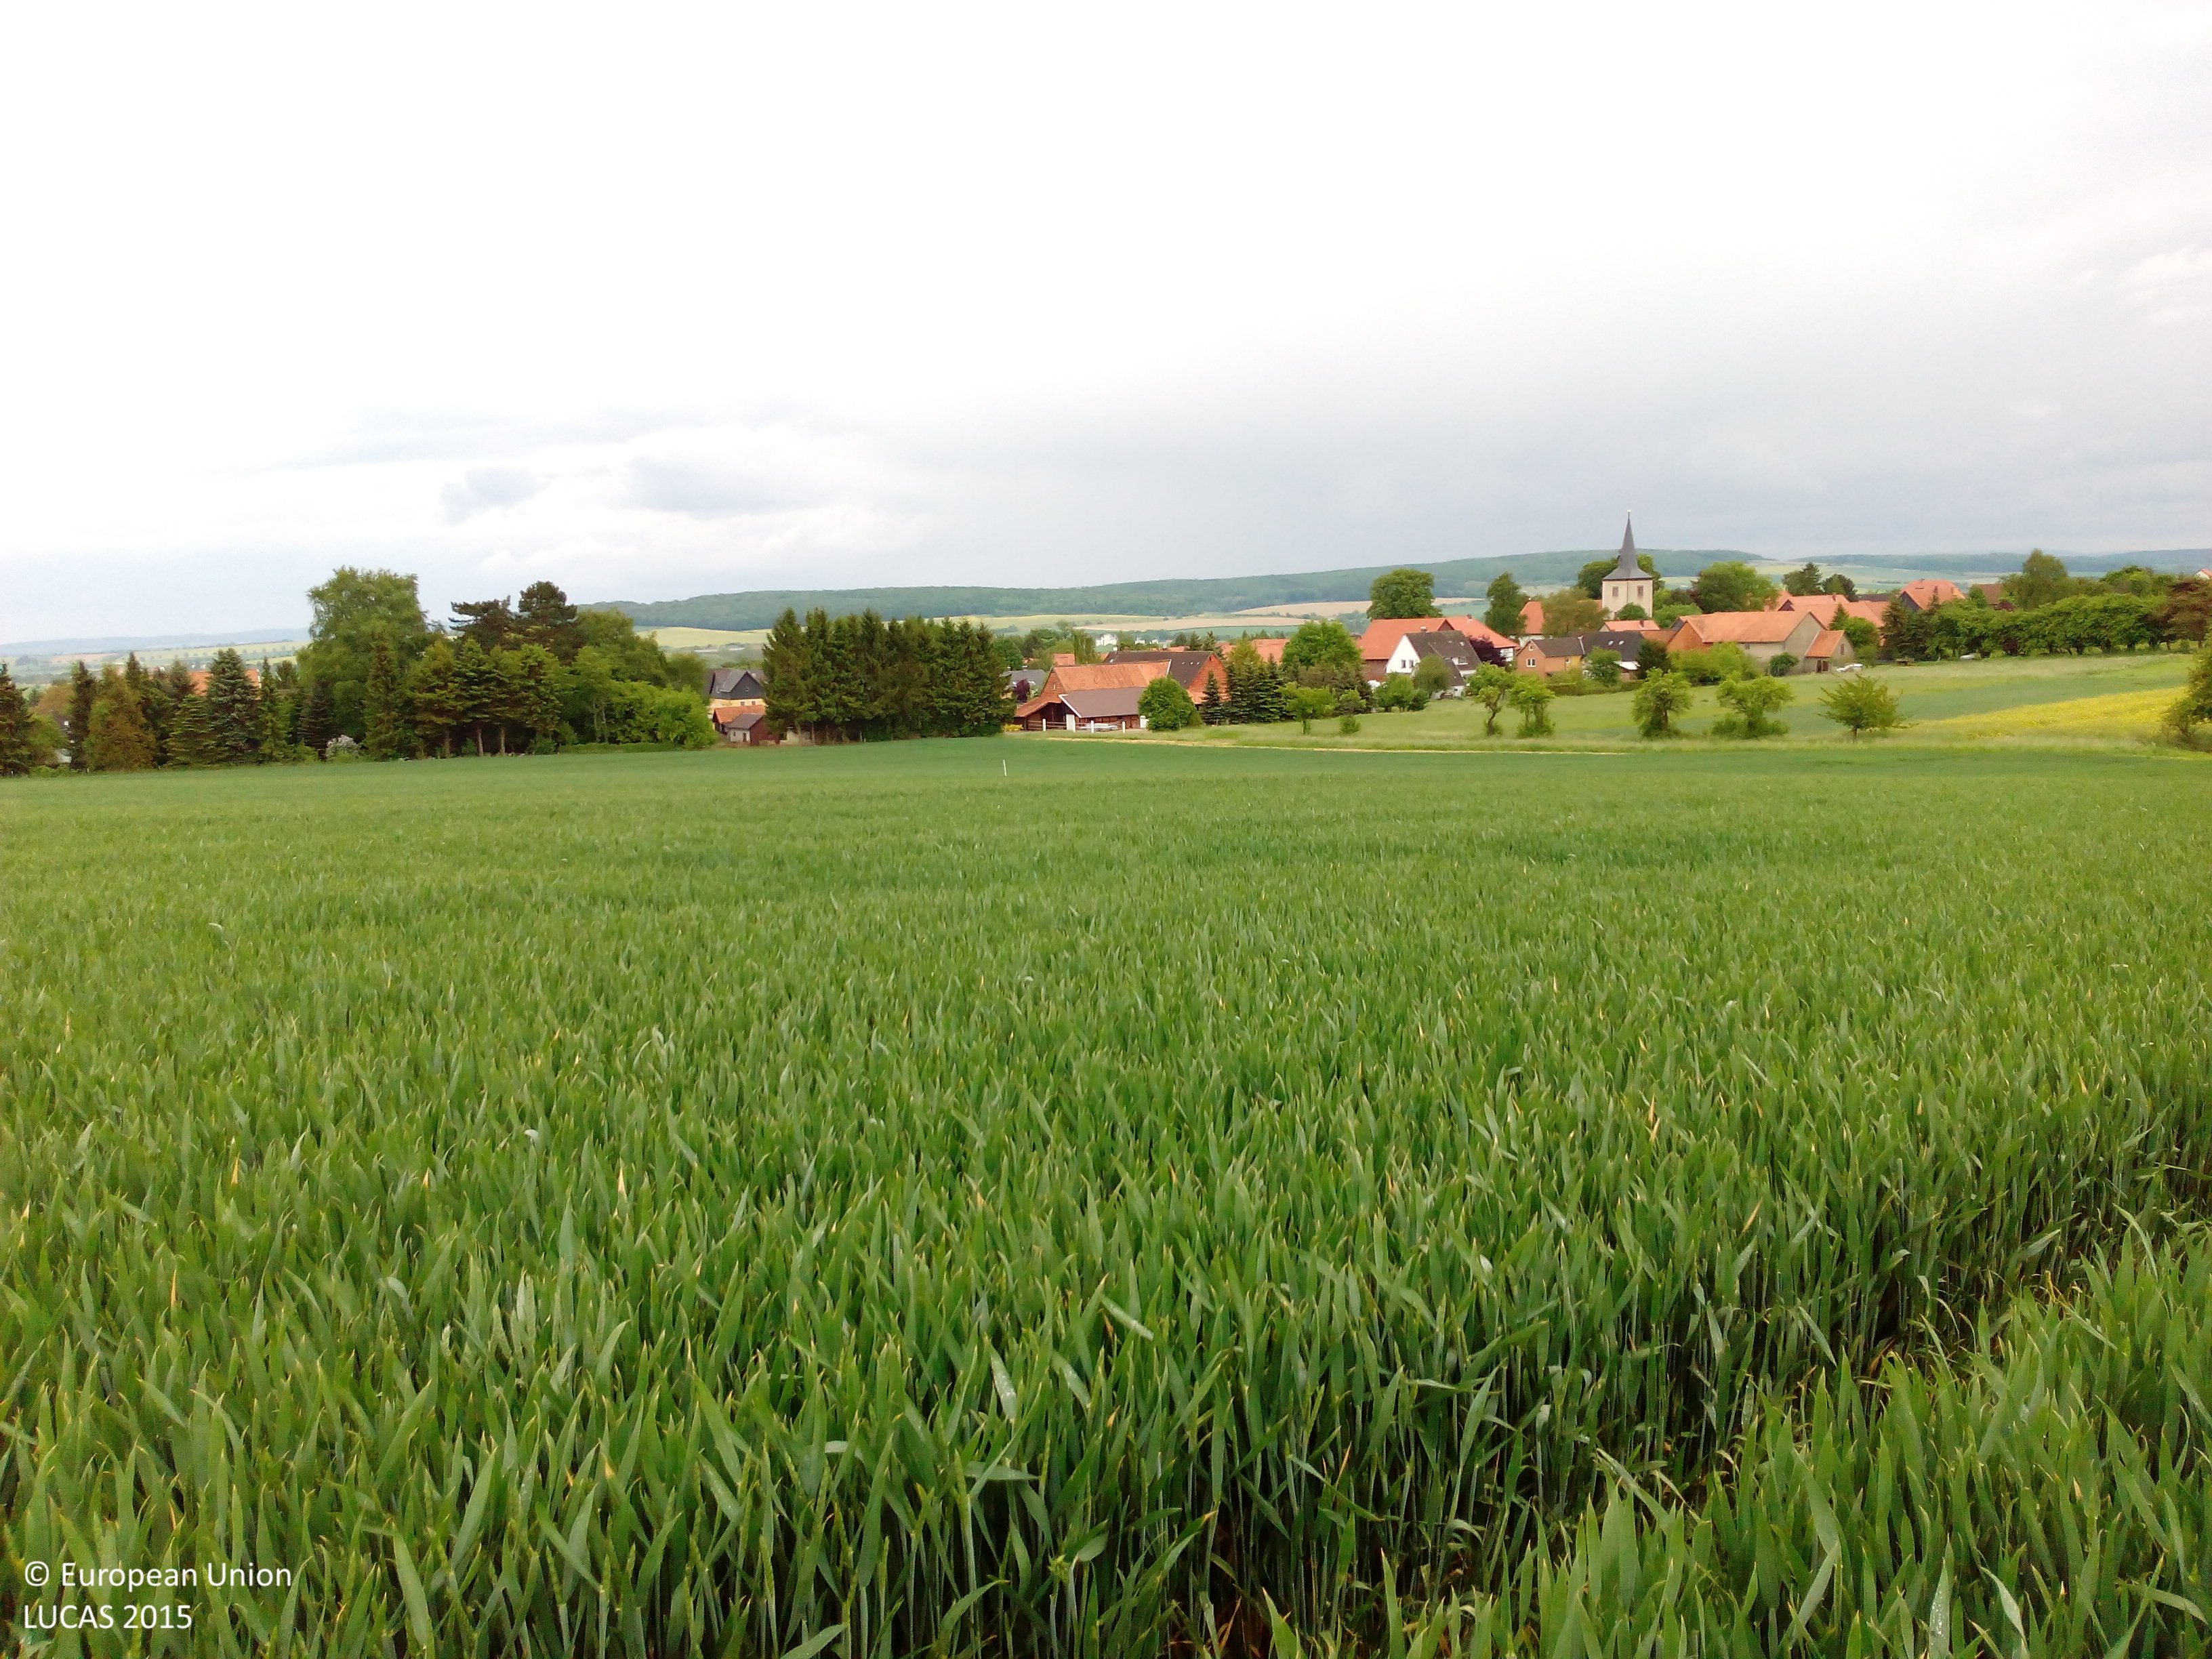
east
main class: Cropland
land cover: Rape and turnip rape
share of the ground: > 75 %
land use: Agriculture (excluding fallow land and kitchen gardens)
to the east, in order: Rape and turnip rape; Common wheat
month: May
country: DE
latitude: 52.0000
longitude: 9.9272
